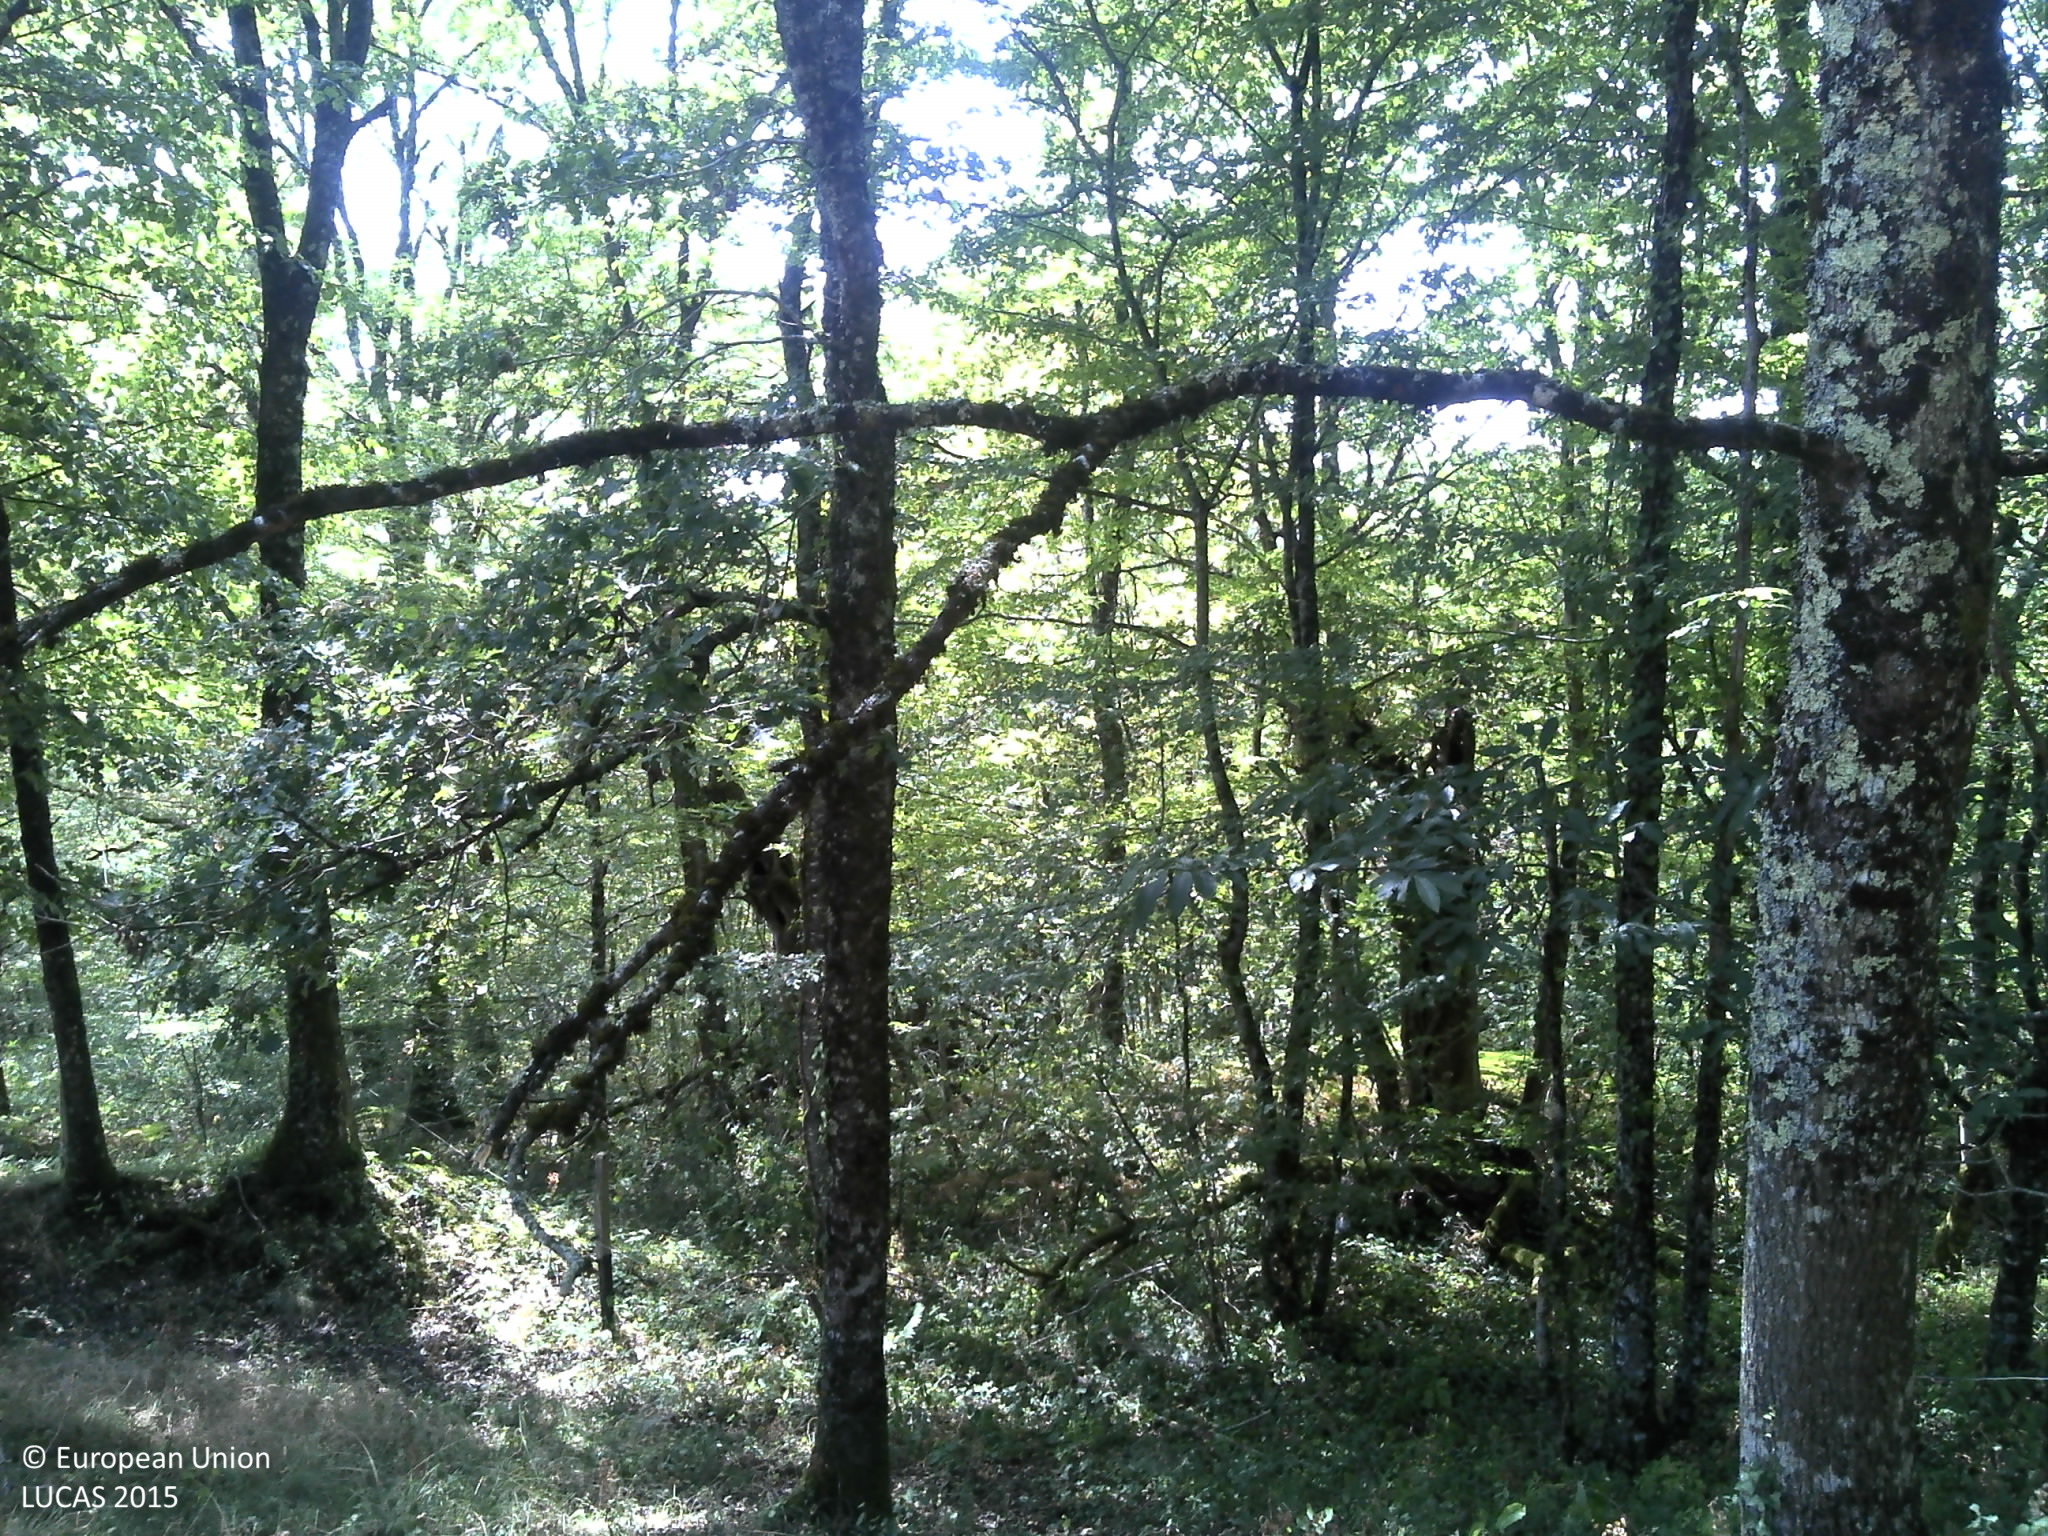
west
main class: Woodland
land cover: Broadleaved woodland
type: thermophilous deciduous forest
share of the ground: > 75 %
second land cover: Grassland without tree/shrub cover
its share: > 75 %
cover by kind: broadleaved forest trees 50 %, herbaceous plants 45 %, lichens and mosses 5 %
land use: Forestry
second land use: Agriculture (excluding fallow land and kitchen gardens)
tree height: > 5 m
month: July
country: FR
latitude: 45.0727
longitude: 1.7533
